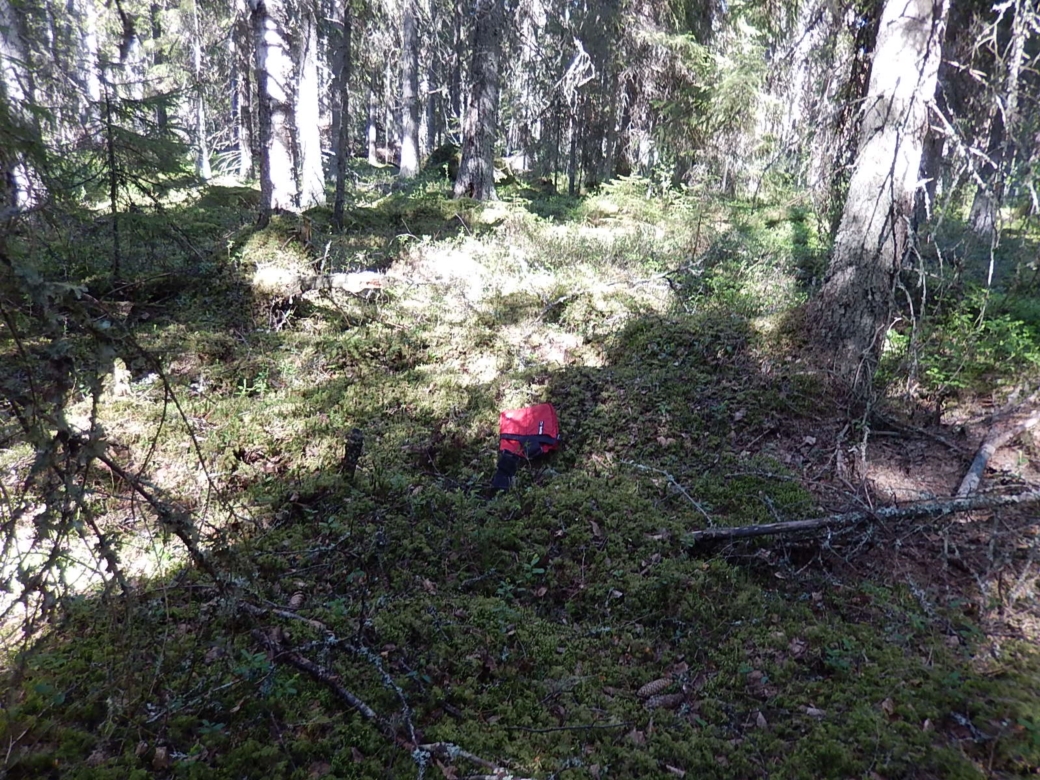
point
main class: Woodland
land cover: Spruce dominated coniferous woodland
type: boreal forest
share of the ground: > 75 %
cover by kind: coniferous forest trees 80 %, shrubs 10 %, lichens and mosses 10 %
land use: Forestry
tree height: > 5 m
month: June
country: FI
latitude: 61.9539
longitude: 21.4669
